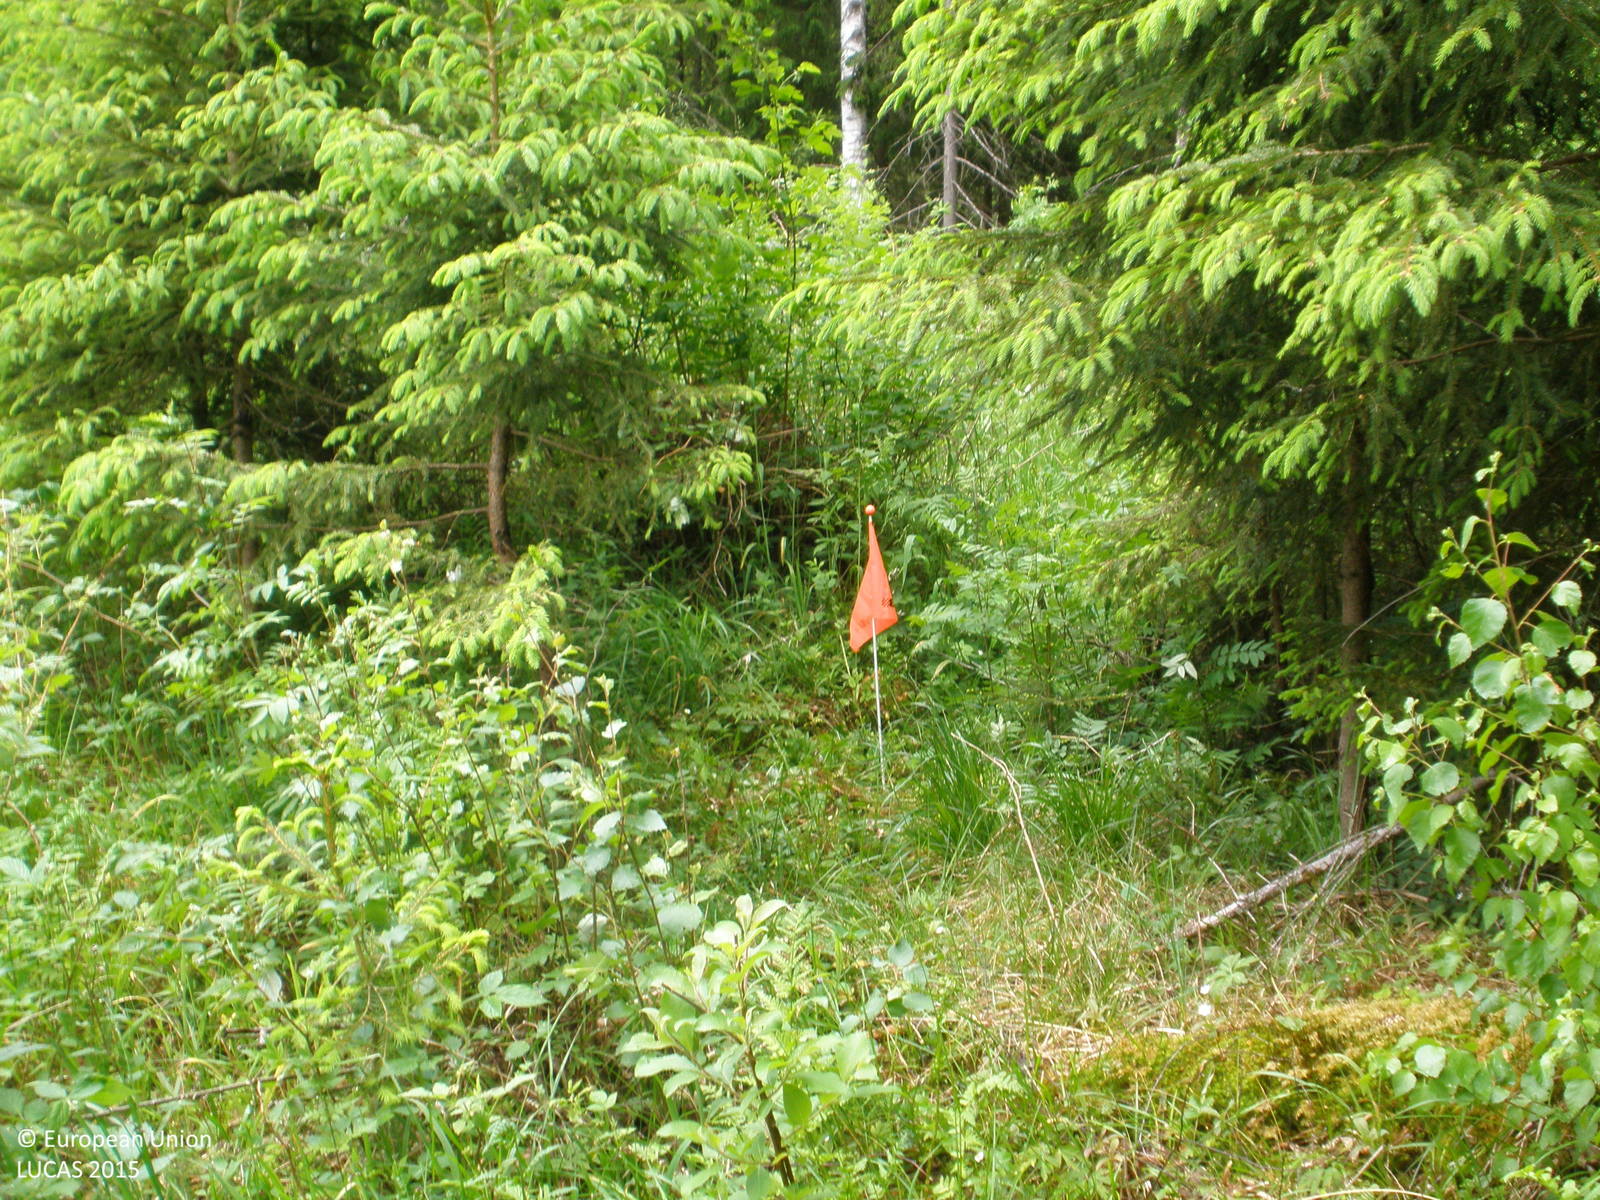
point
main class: Woodland
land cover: Spruce dominated mixed woodland
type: boreal forest
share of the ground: 25 - 50 %
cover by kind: herbaceous plants 35 %, broadleaved forest trees 30 %, coniferous forest trees 25 %, shrubs 10 %
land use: Forestry
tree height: < 5 m
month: June
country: FI
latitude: 61.1339
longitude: 24.4923
